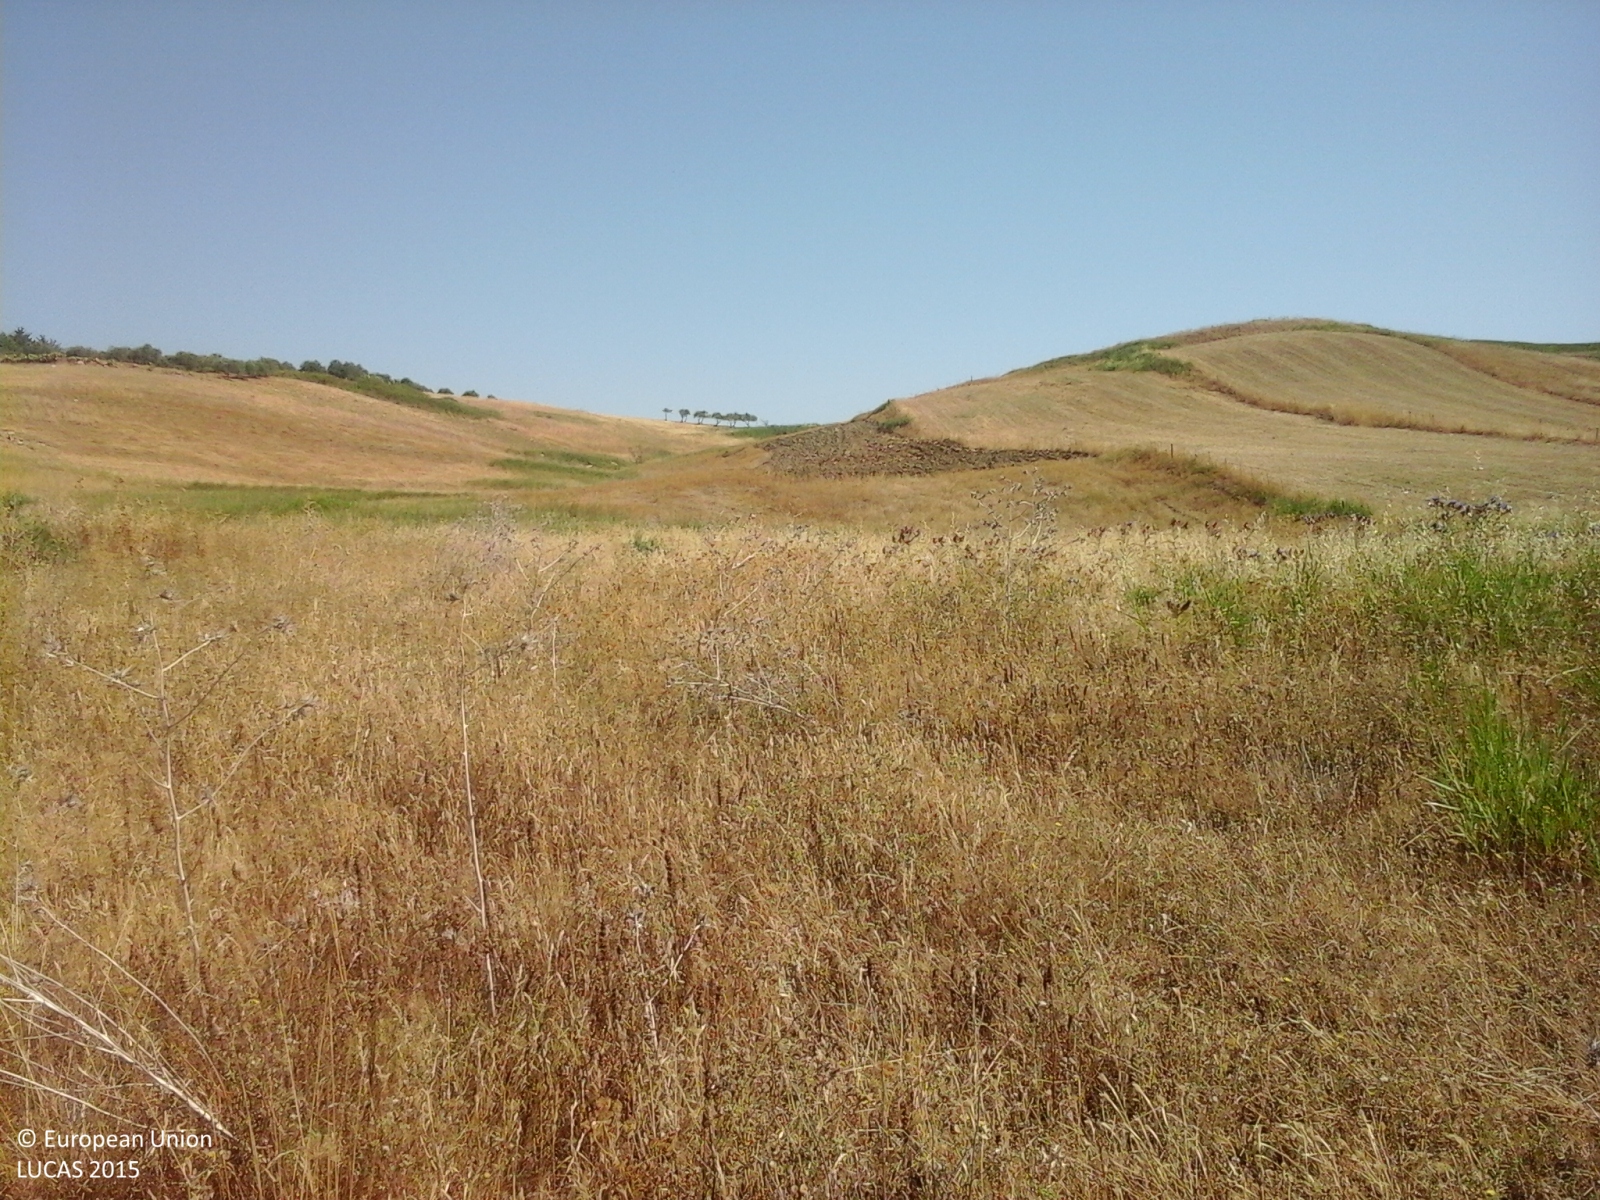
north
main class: Grassland
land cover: Spontaneously vegetated surfaces
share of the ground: > 75 %
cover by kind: herbaceous plants 100 %
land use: Fallow land
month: July
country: IT
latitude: 37.3533
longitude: 13.5736
